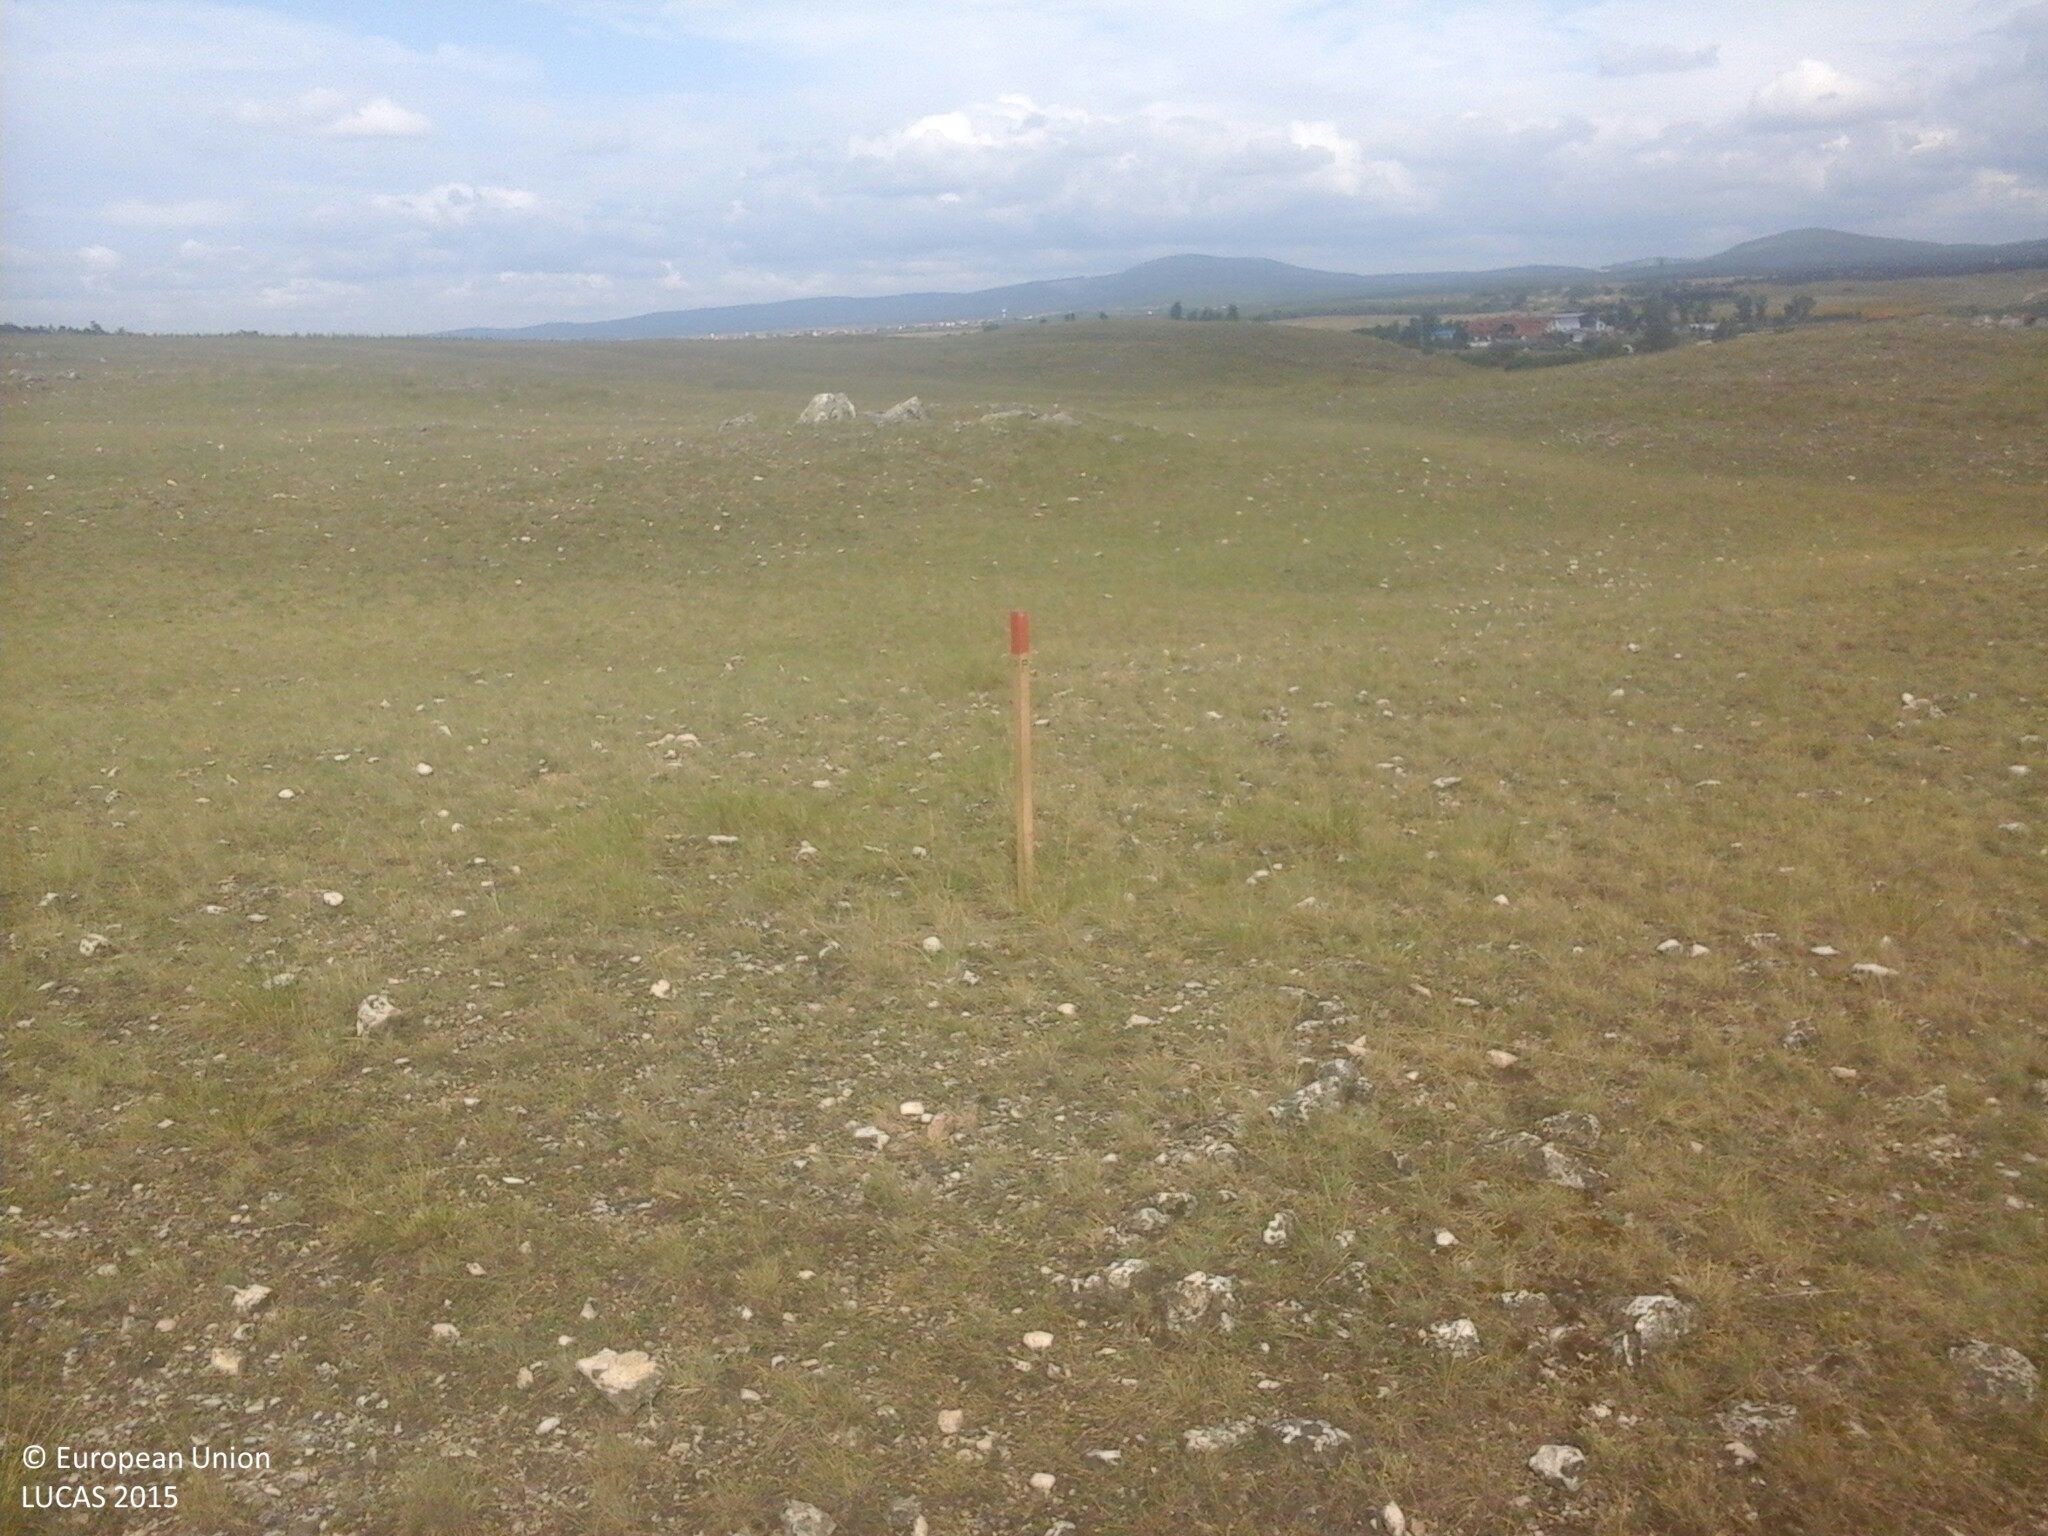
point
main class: Grassland
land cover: Grassland without tree/shrub cover
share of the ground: > 75 %
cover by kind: herbaceous plants 80 %, consolidated bare surface 20 %
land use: Semi-natural and natural areas not in use
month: July
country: HU
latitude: 47.1358
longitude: 18.0127
